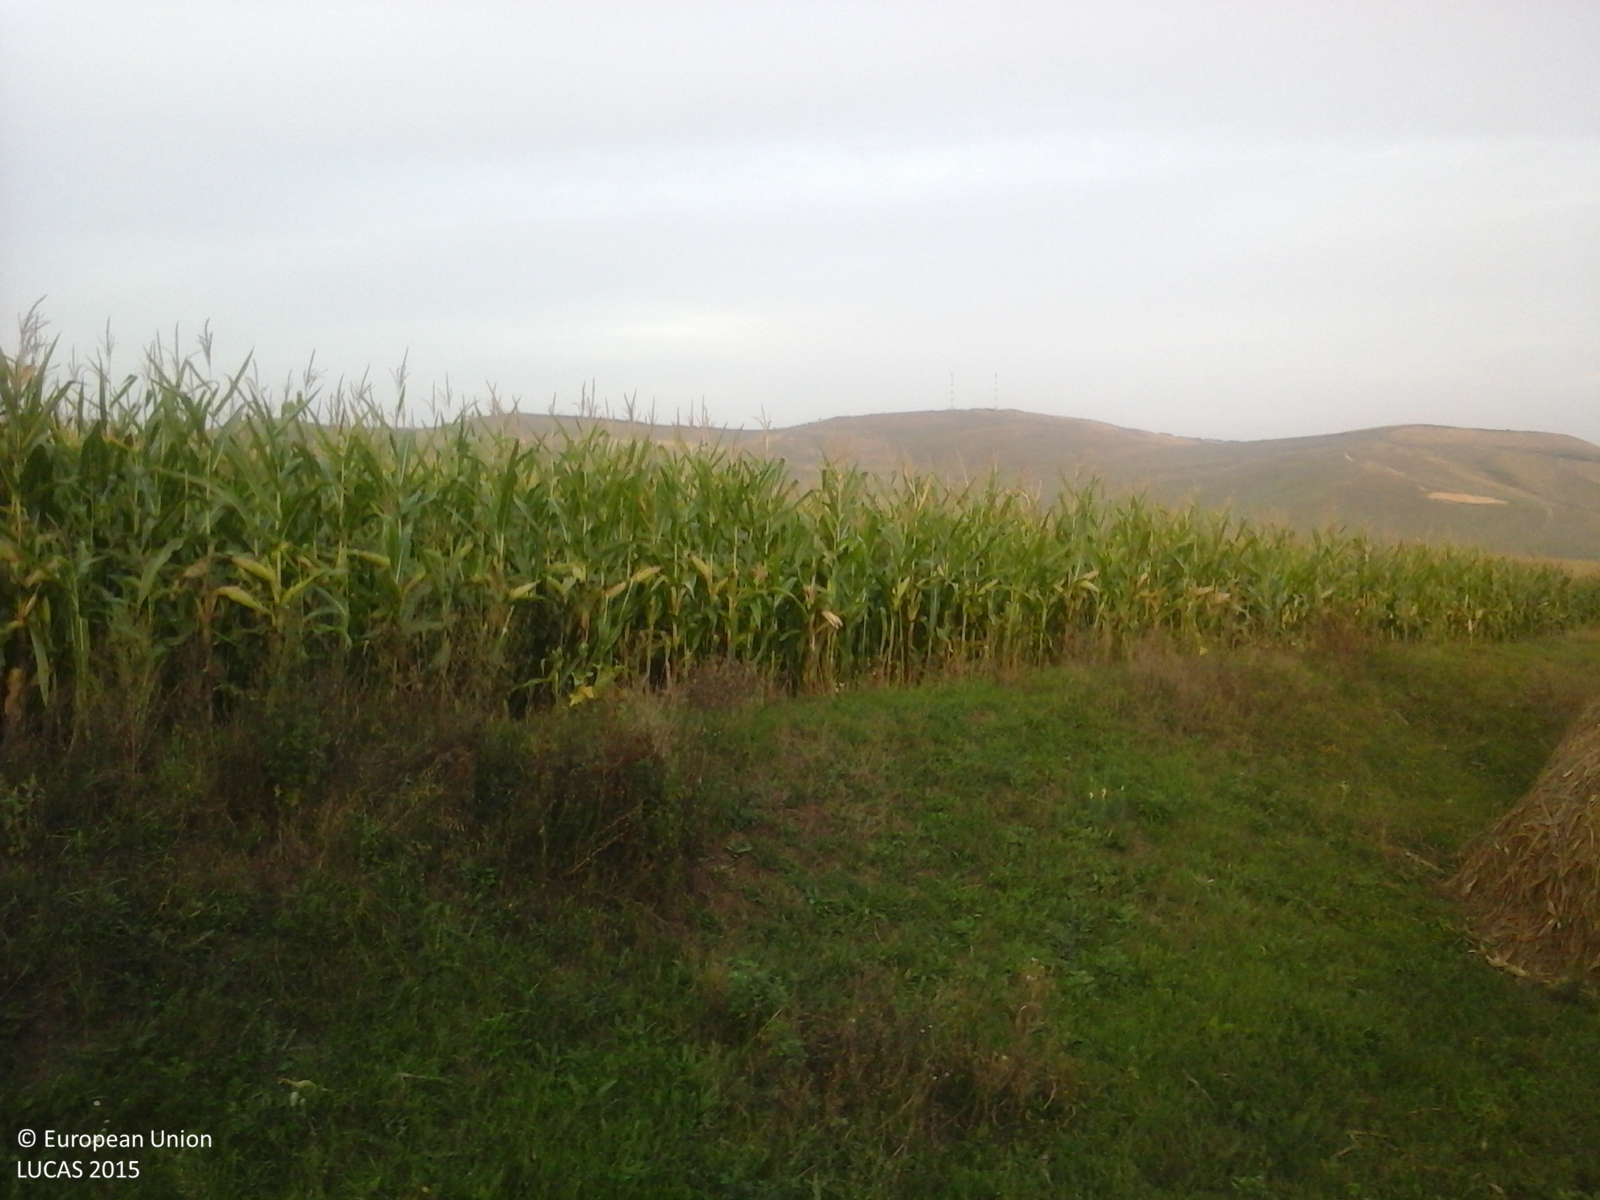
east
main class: Cropland
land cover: Maize
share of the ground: > 75 %
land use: Agriculture (excluding fallow land and kitchen gardens)
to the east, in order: Maize
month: September
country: RO
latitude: 46.7346
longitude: 24.0426
